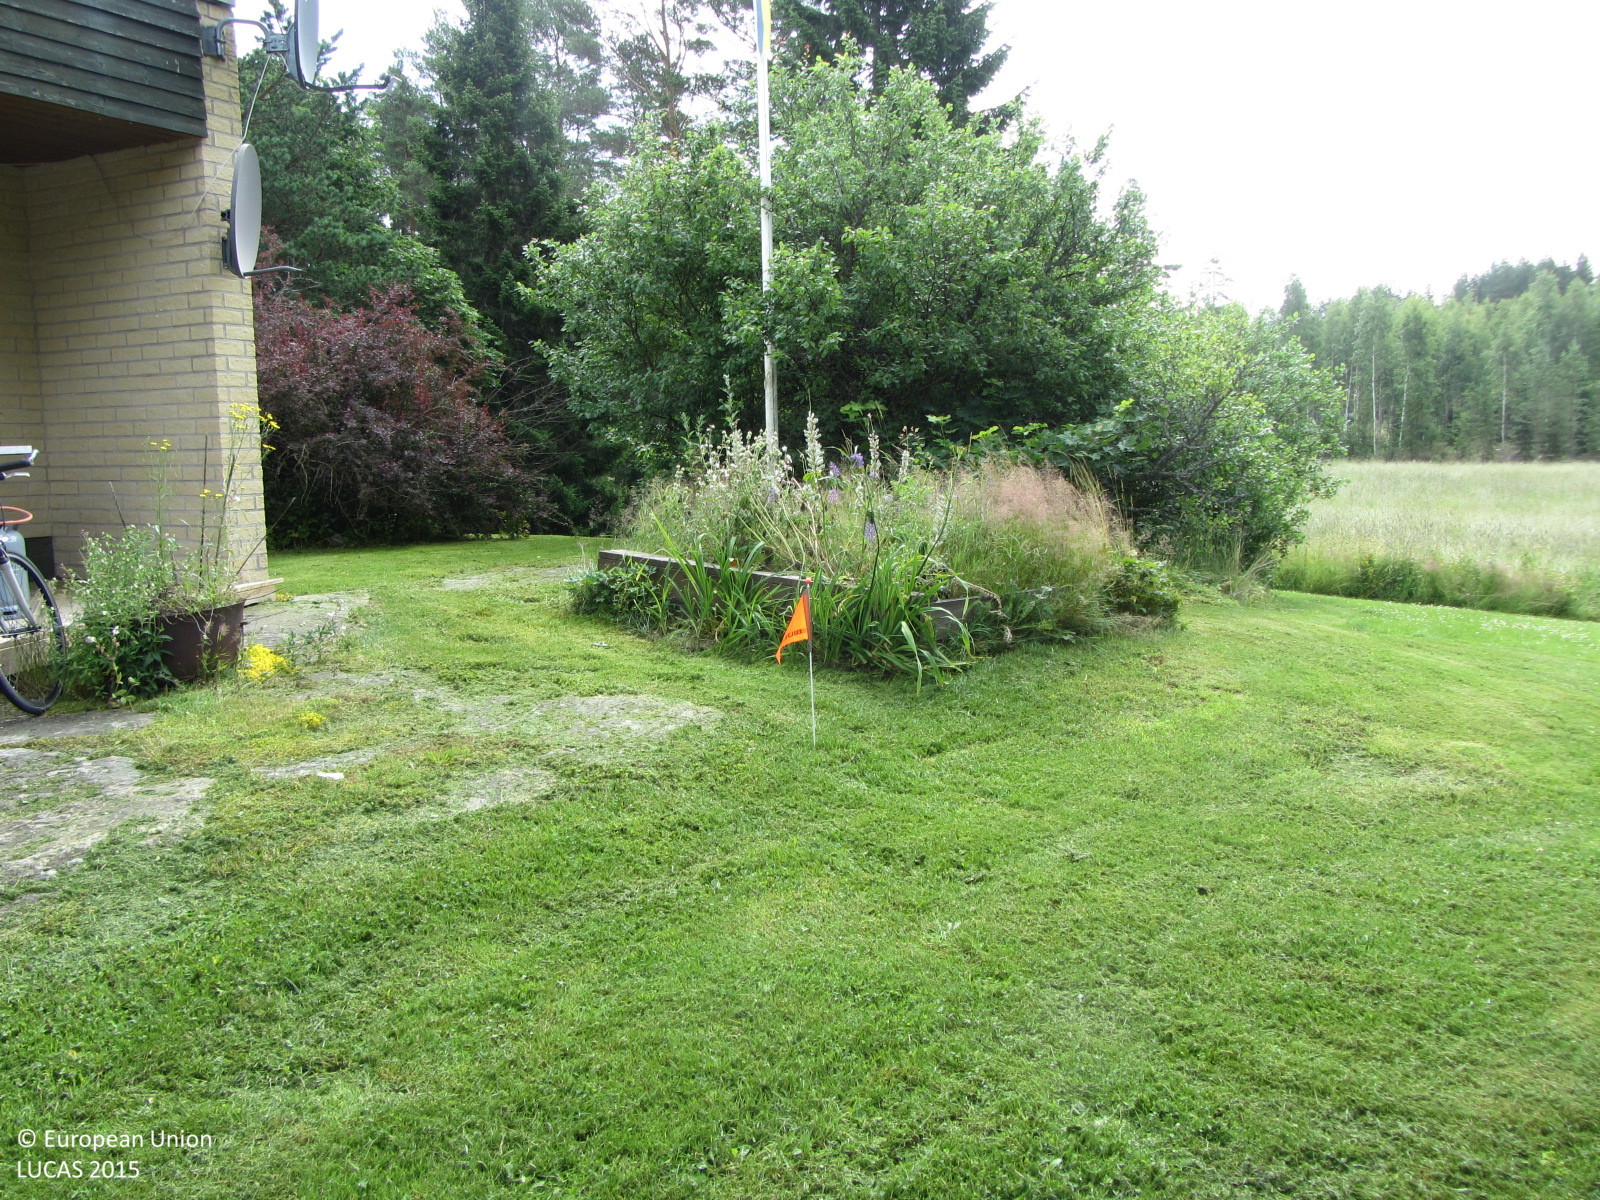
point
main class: Grassland
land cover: Grassland with sparse tree/shrub cover
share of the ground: > 75 %
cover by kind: herbaceous plants 85 %, shrubs 10 %, broadleaved forest trees 5 %
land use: Residential
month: July
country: FI
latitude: 60.0724
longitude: 24.0992
